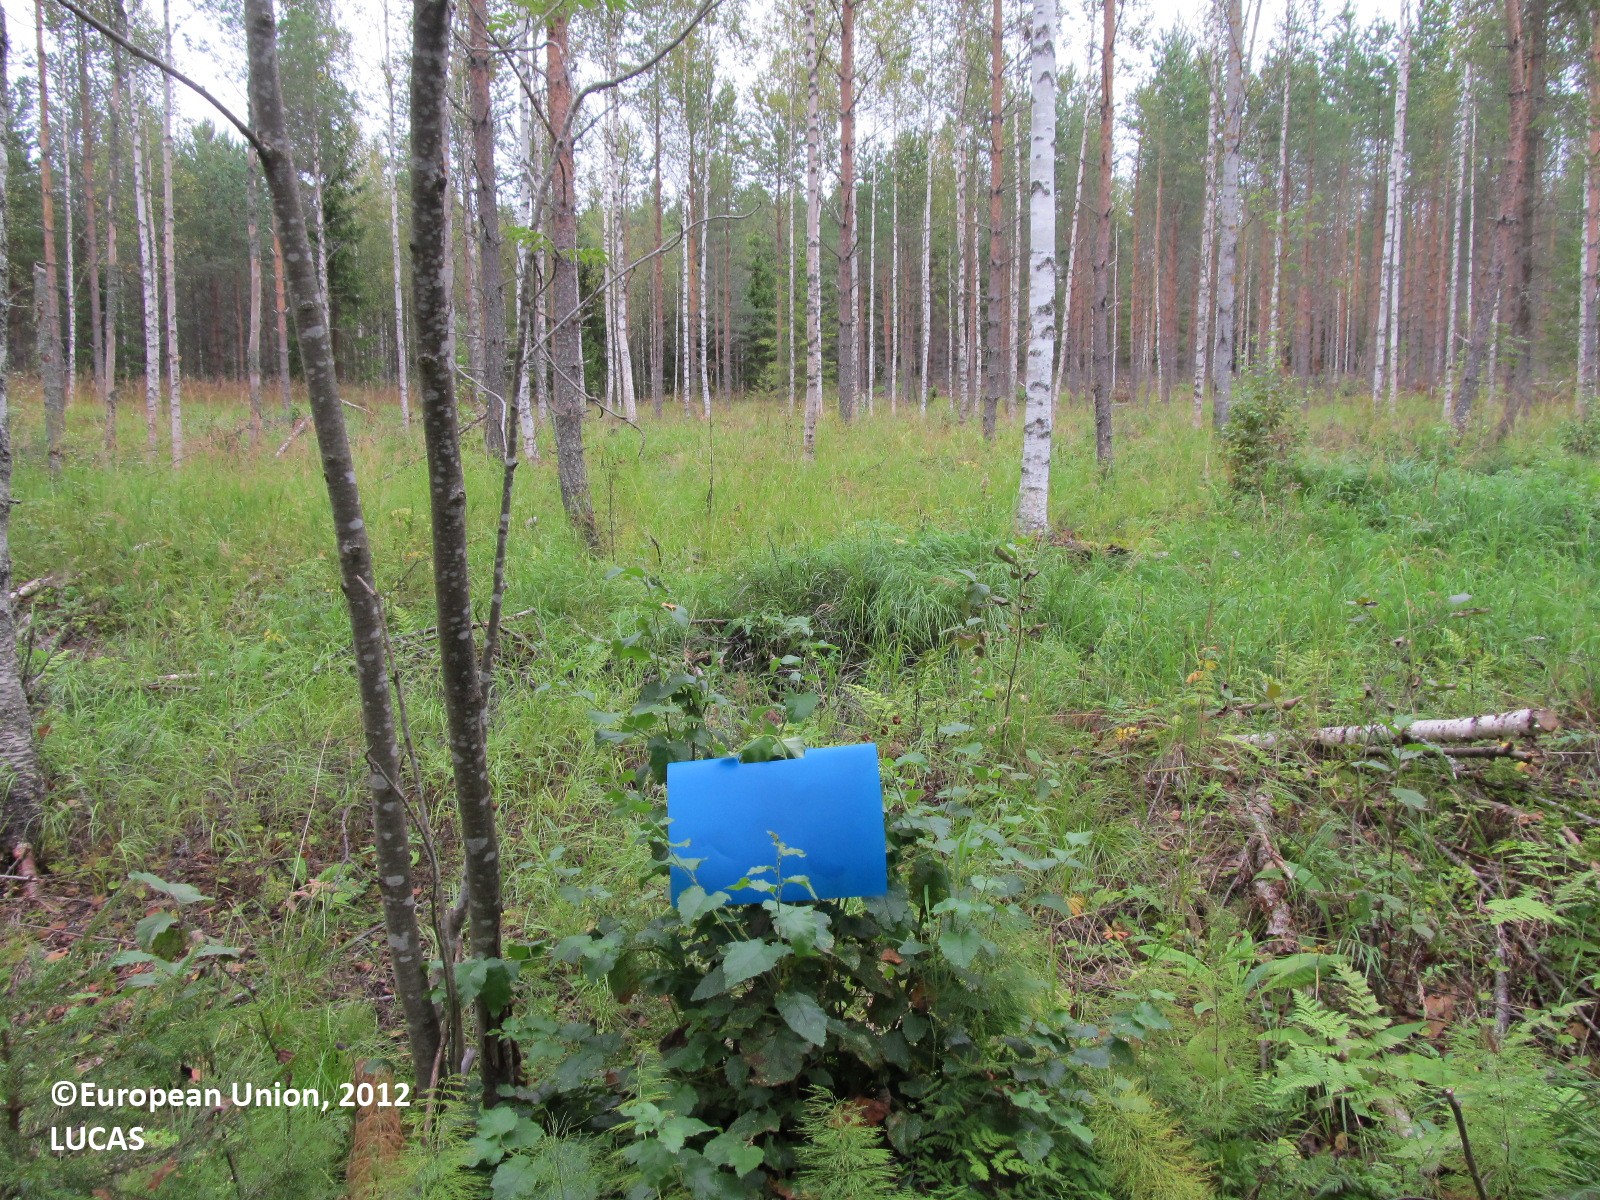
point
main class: Woodland
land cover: Pine dominated mixed woodland
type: boreal forest
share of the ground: 25 - 50 %
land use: Forestry
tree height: > 5 m
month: August
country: FI
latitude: 63.1486
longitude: 27.8529
